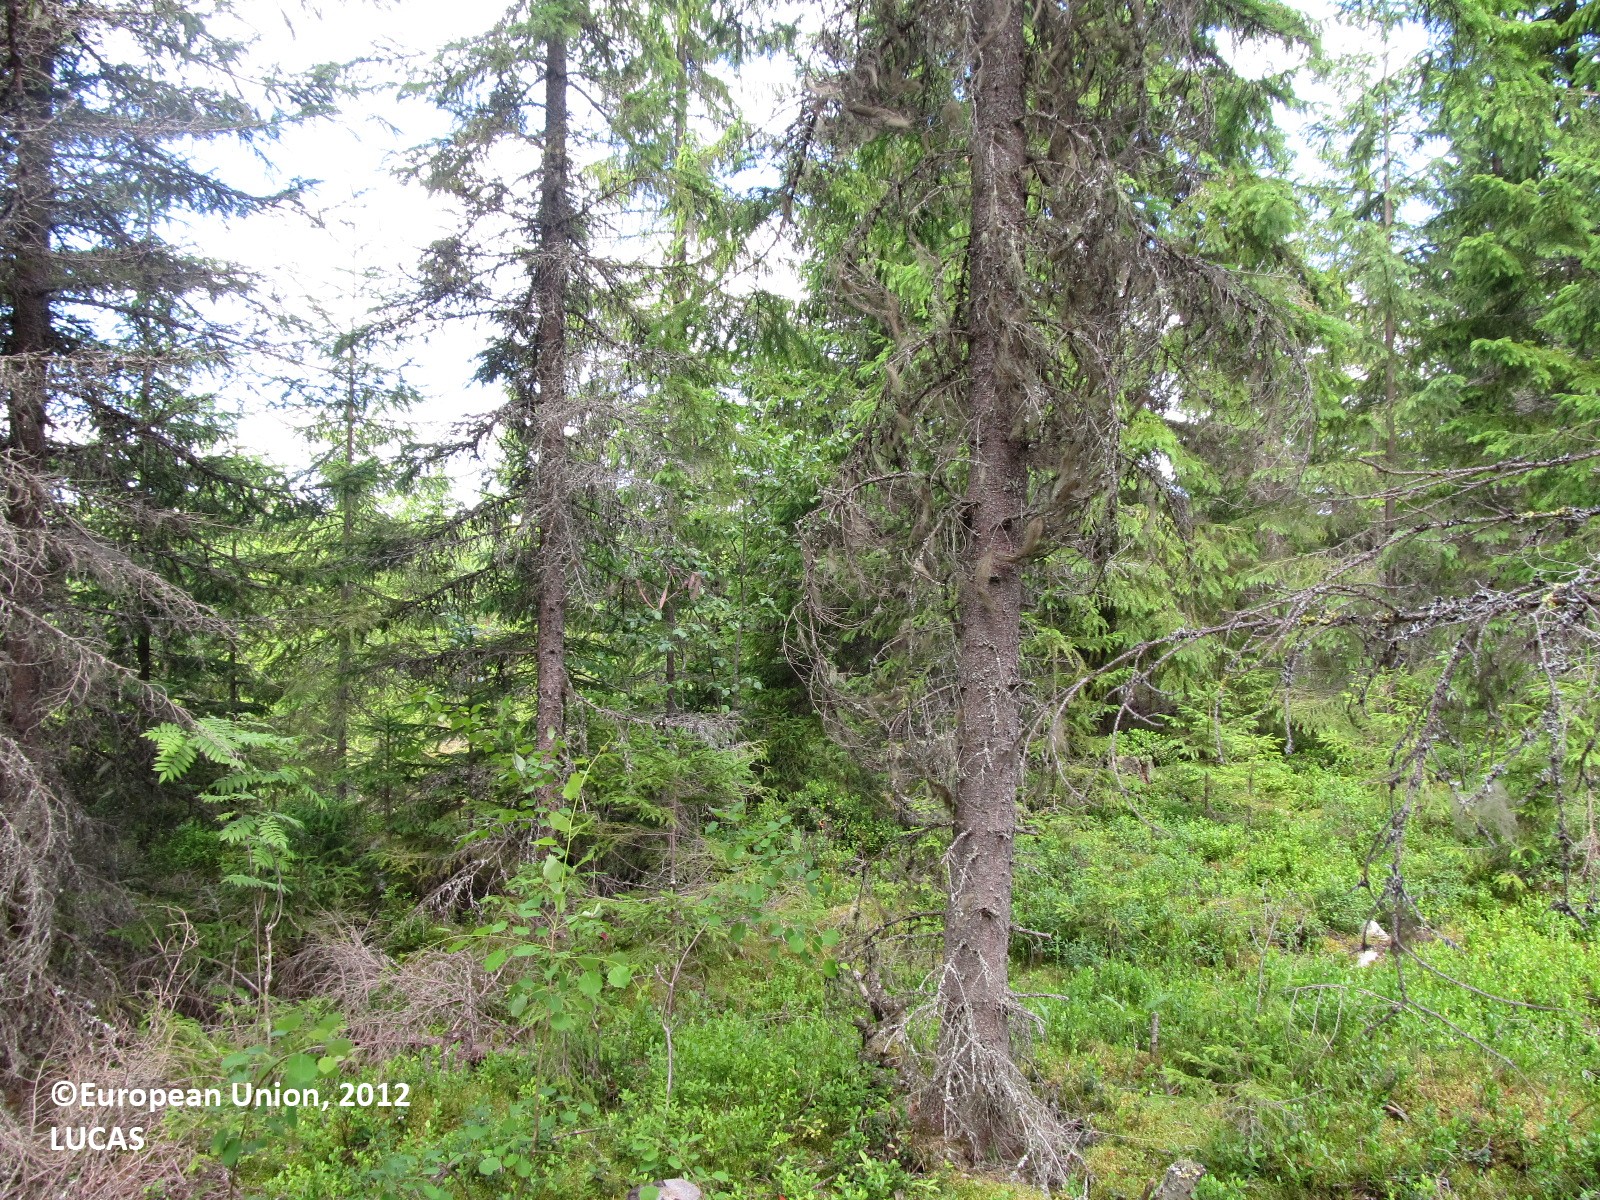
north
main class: Woodland
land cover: Spruce dominated coniferous woodland
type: boreal forest
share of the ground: 50 - 75 %
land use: Forestry
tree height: > 5 m
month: July
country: FI
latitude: 62.4395
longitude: 28.9124
